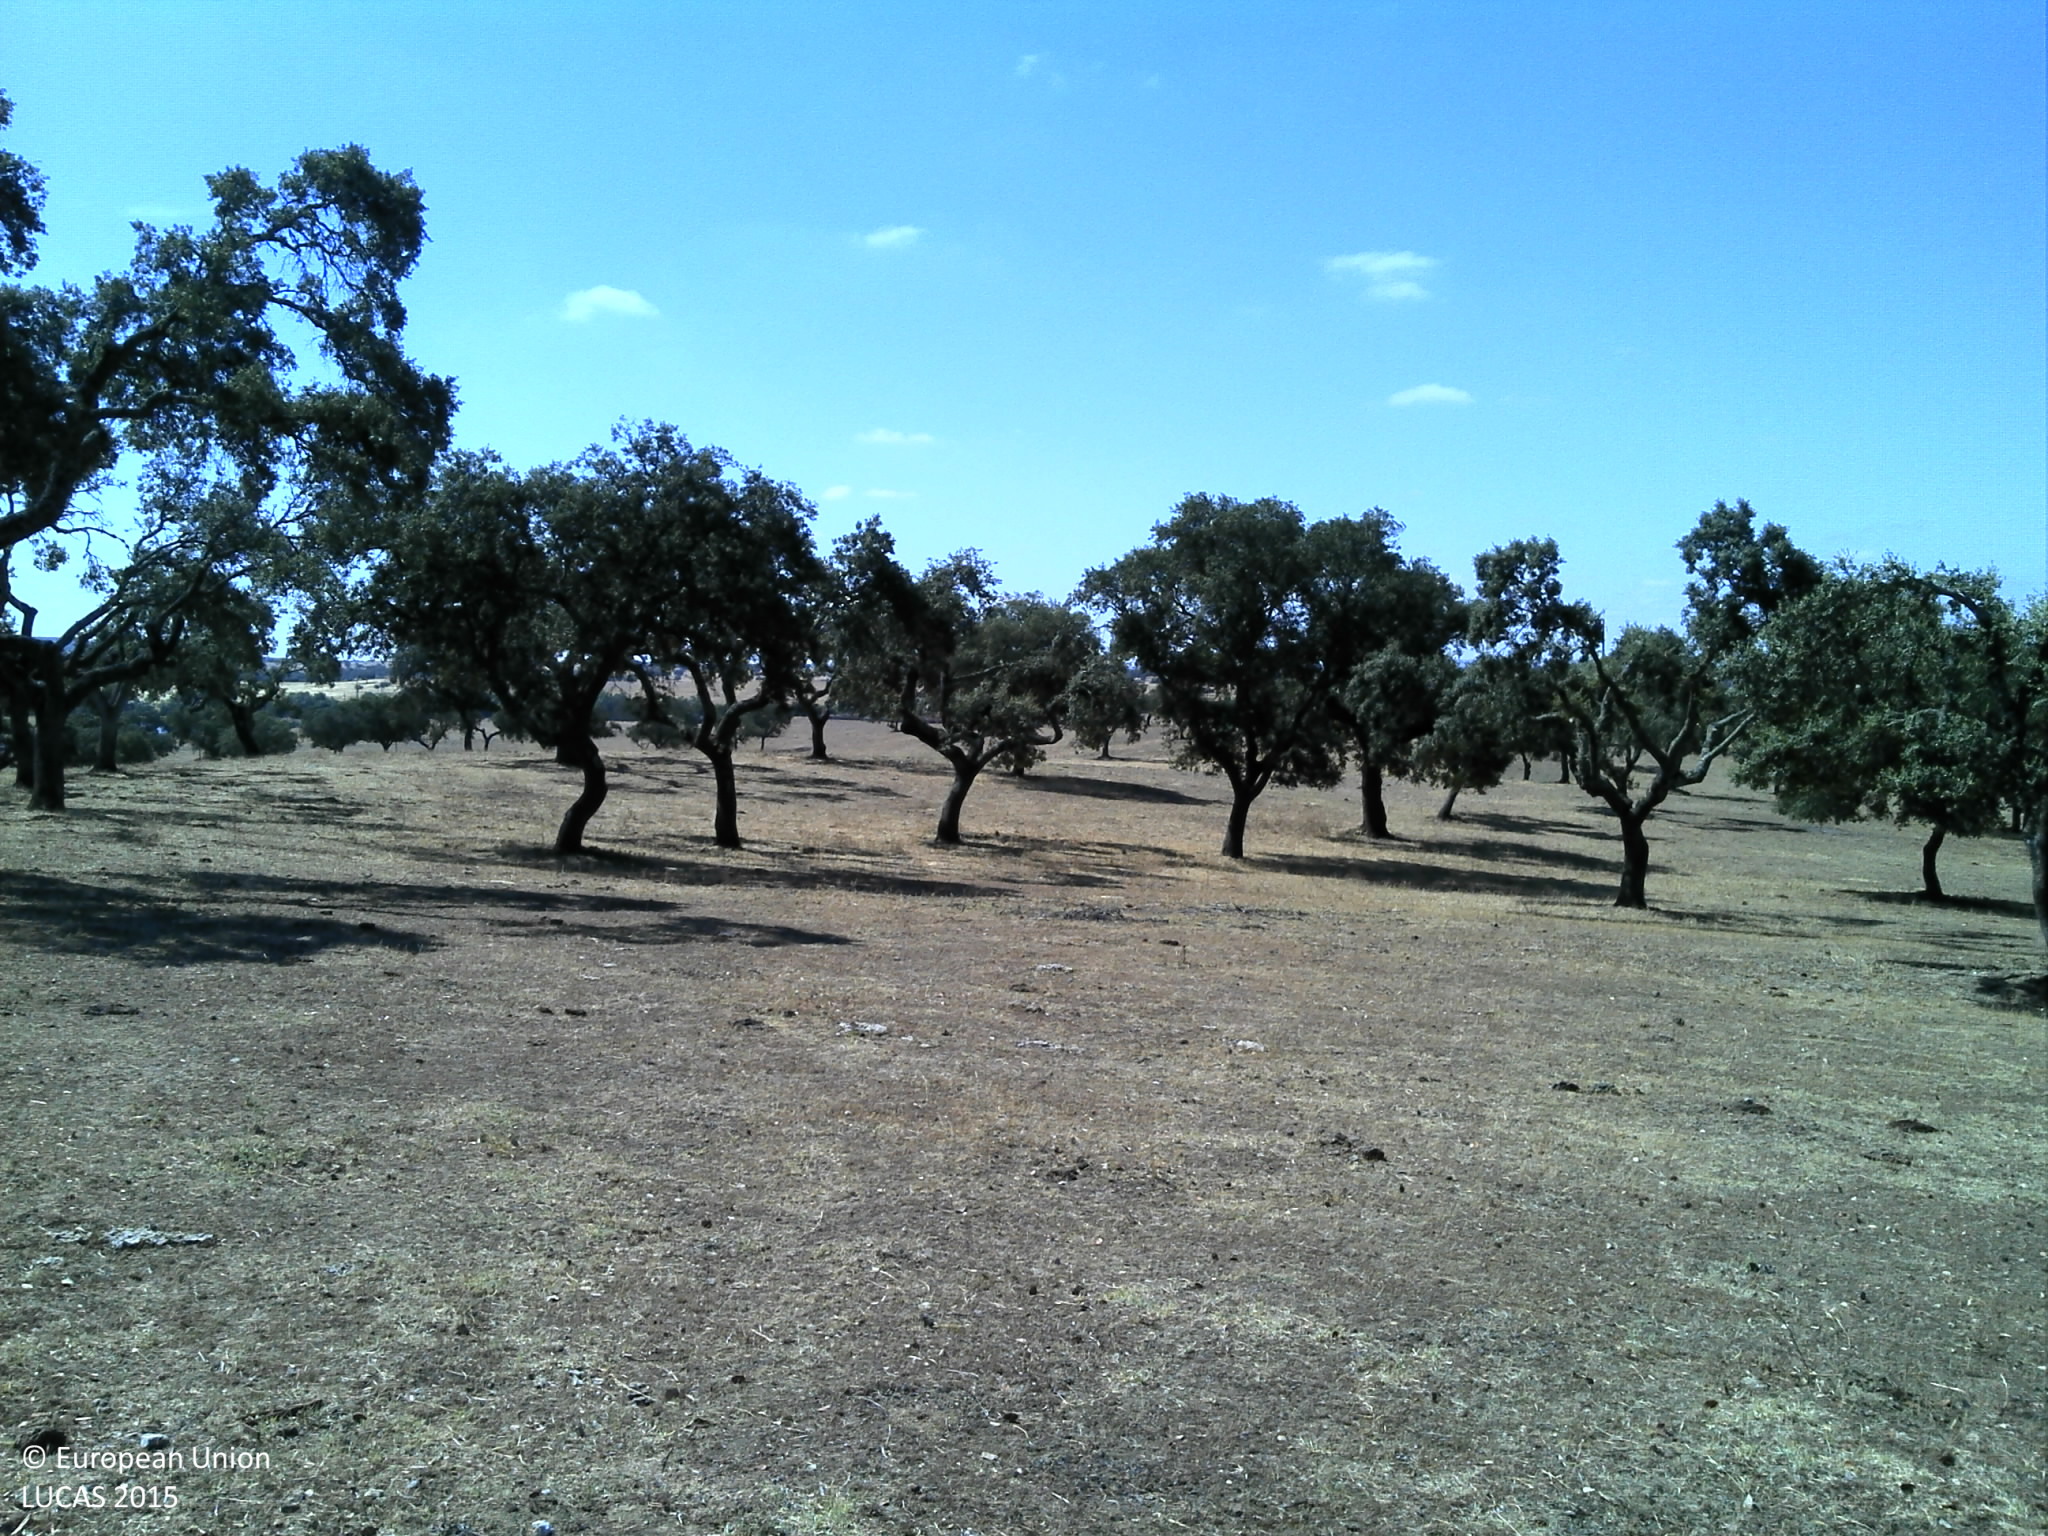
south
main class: Woodland
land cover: Broadleaved woodland
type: broadleaved evergreen forest
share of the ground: 10 - 25 %
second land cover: Grassland without tree/shrub cover
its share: < 10 %
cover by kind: unconsolidated bare surface 80 %, broadleaved forest trees 10 %, herbaceous plants 10 %
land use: Forestry
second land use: Agriculture (excluding fallow land and kitchen gardens)
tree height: > 5 m
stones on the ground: < 10 %
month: June
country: PT
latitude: 38.2963
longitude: -8.0699
